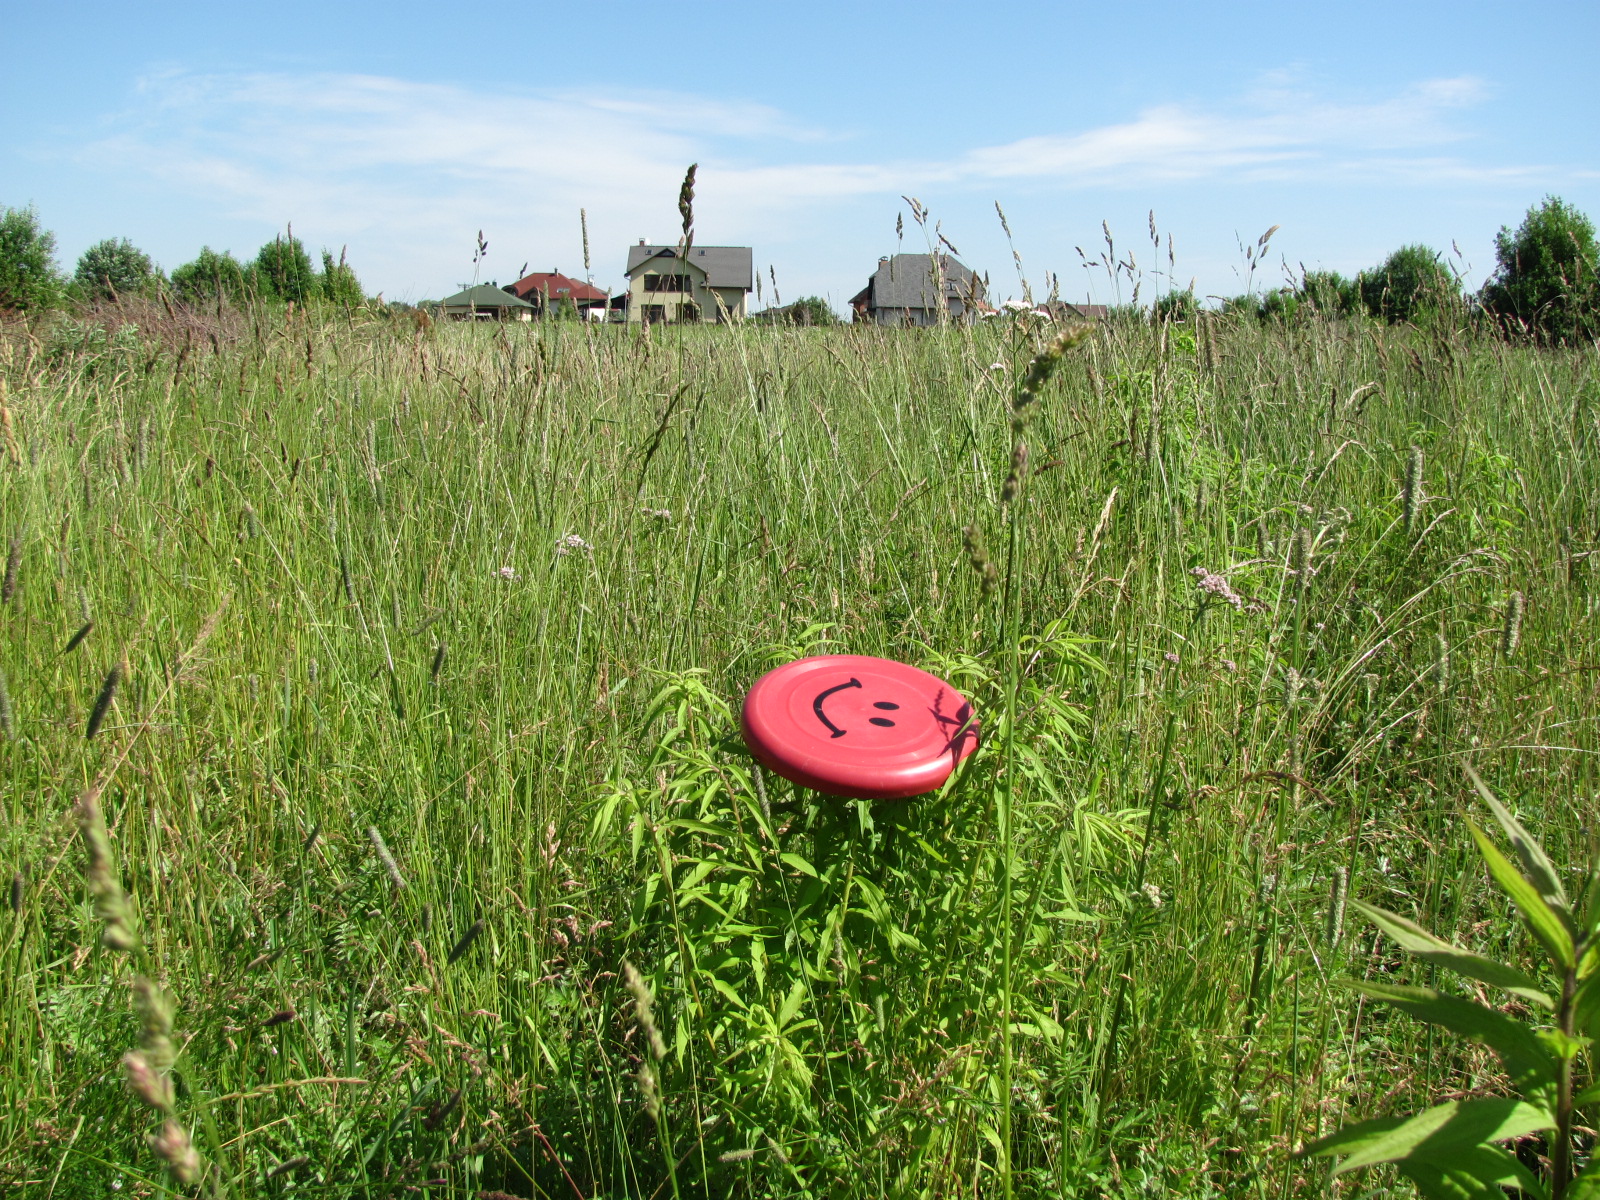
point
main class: Grassland
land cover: Grassland with sparse tree/shrub cover
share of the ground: > 75 %
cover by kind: herbaceous plants 95 %, broadleaved forest trees 5 %
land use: Abandoned areas
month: July
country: LV
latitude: 56.8763
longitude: 24.1820
